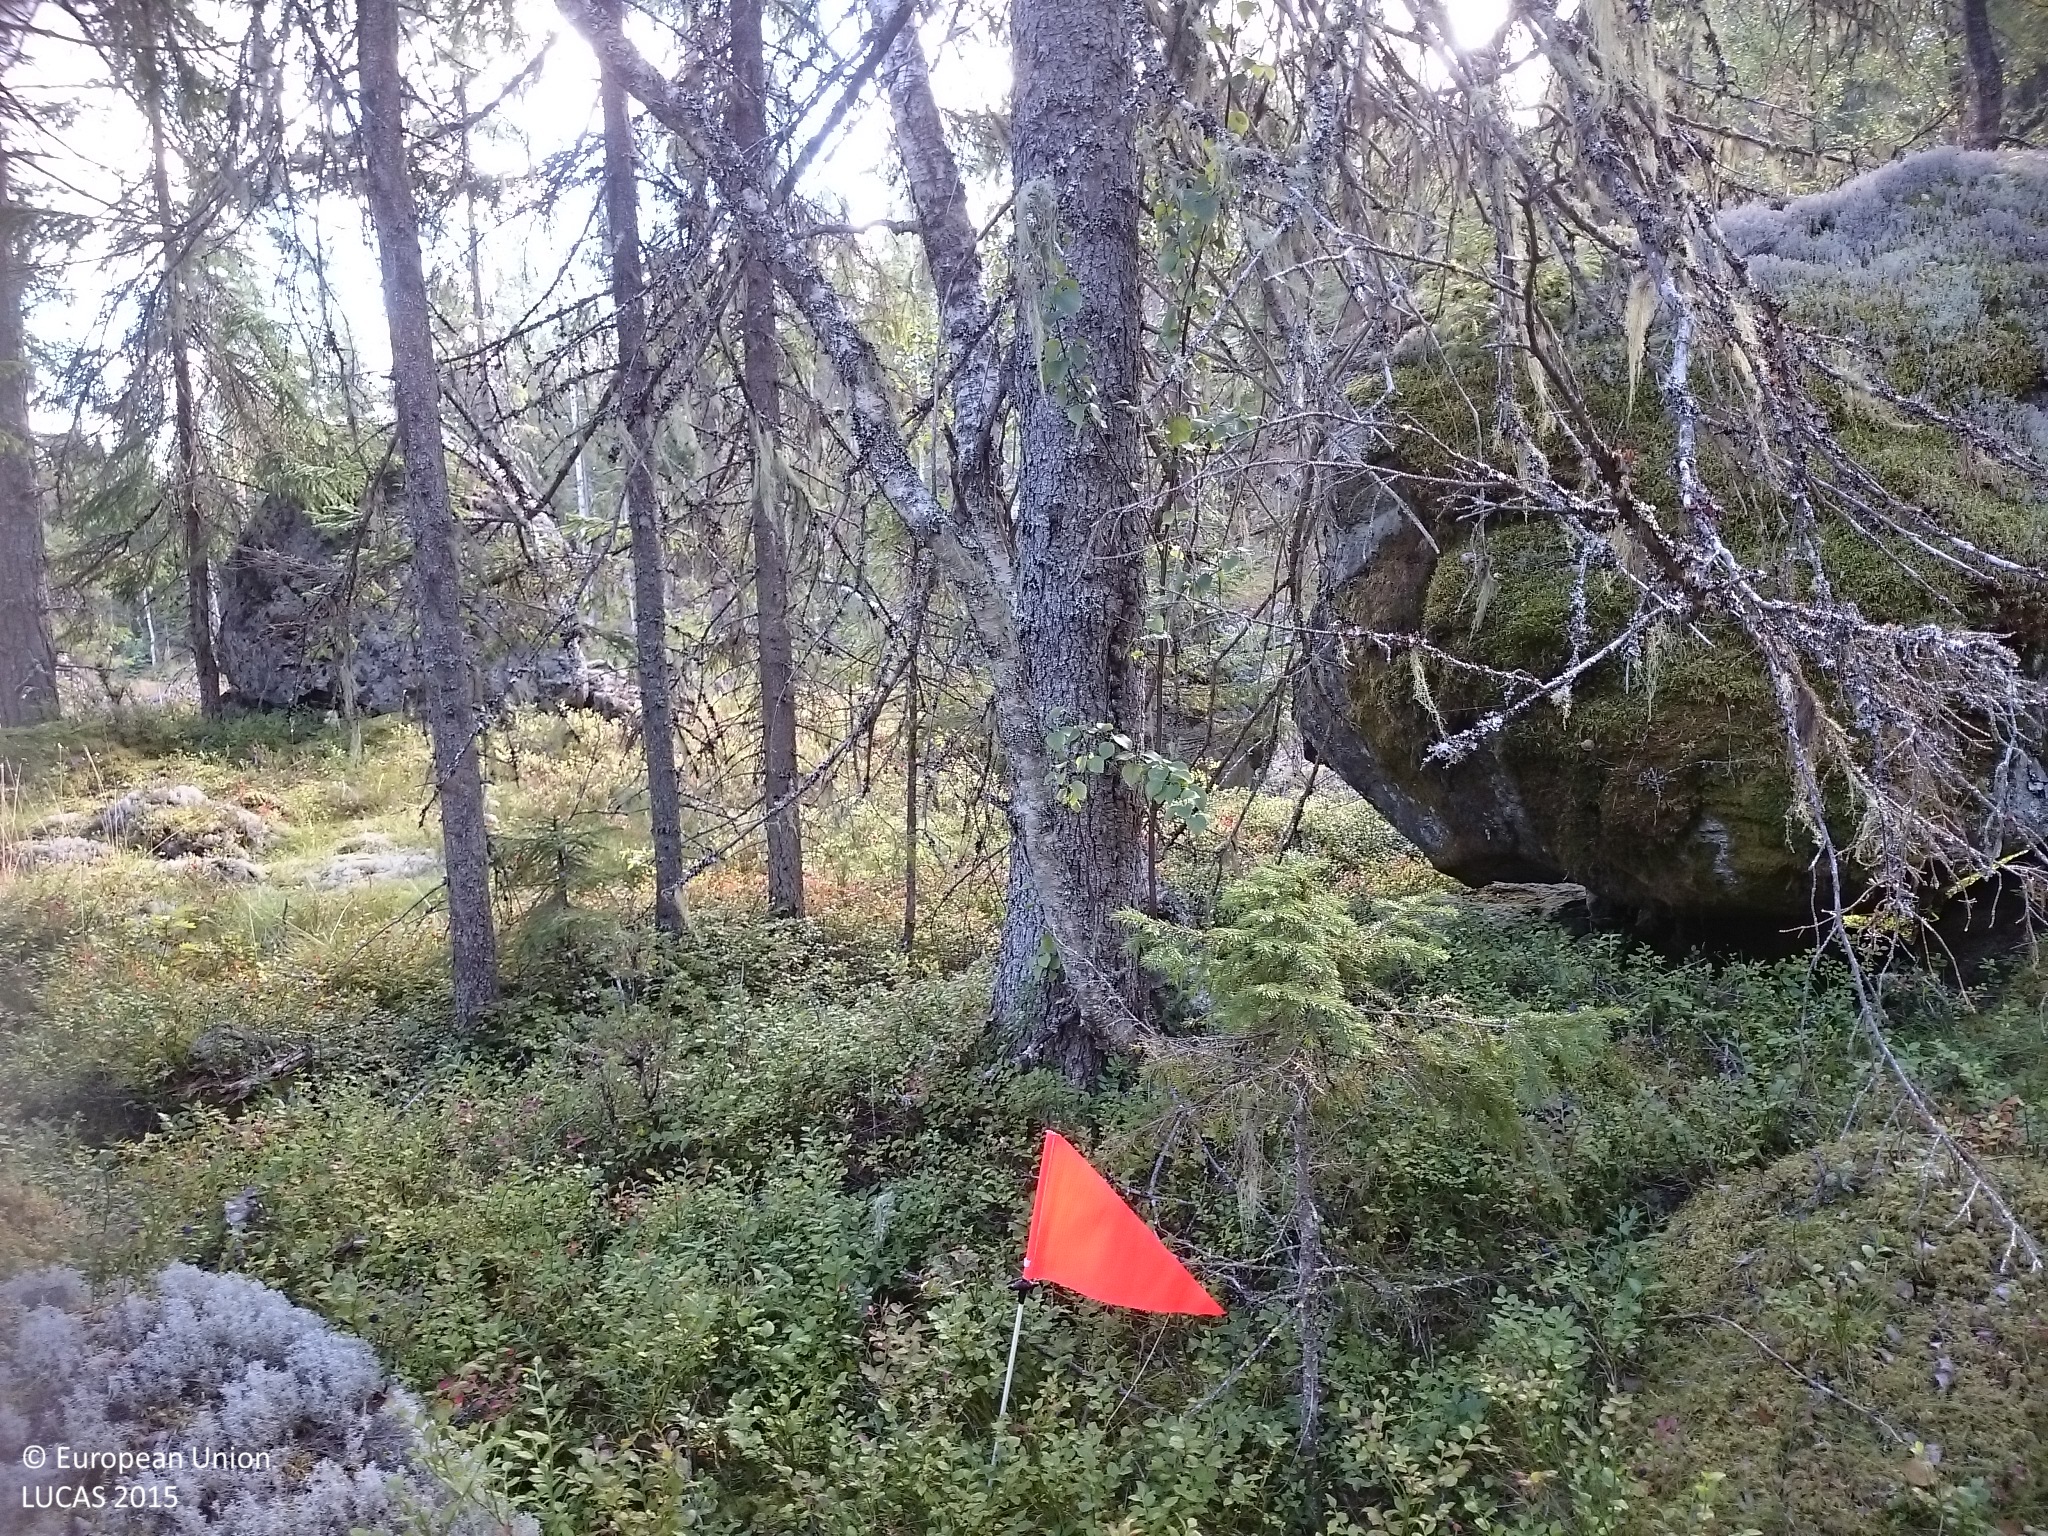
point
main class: Woodland
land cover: Spruce dominated coniferous woodland
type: boreal forest
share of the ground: 25 - 50 %
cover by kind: coniferous forest trees 50 %, shrubs 50 %
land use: Forestry
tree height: > 5 m
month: September
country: SE
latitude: 62.4184
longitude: 16.8912
